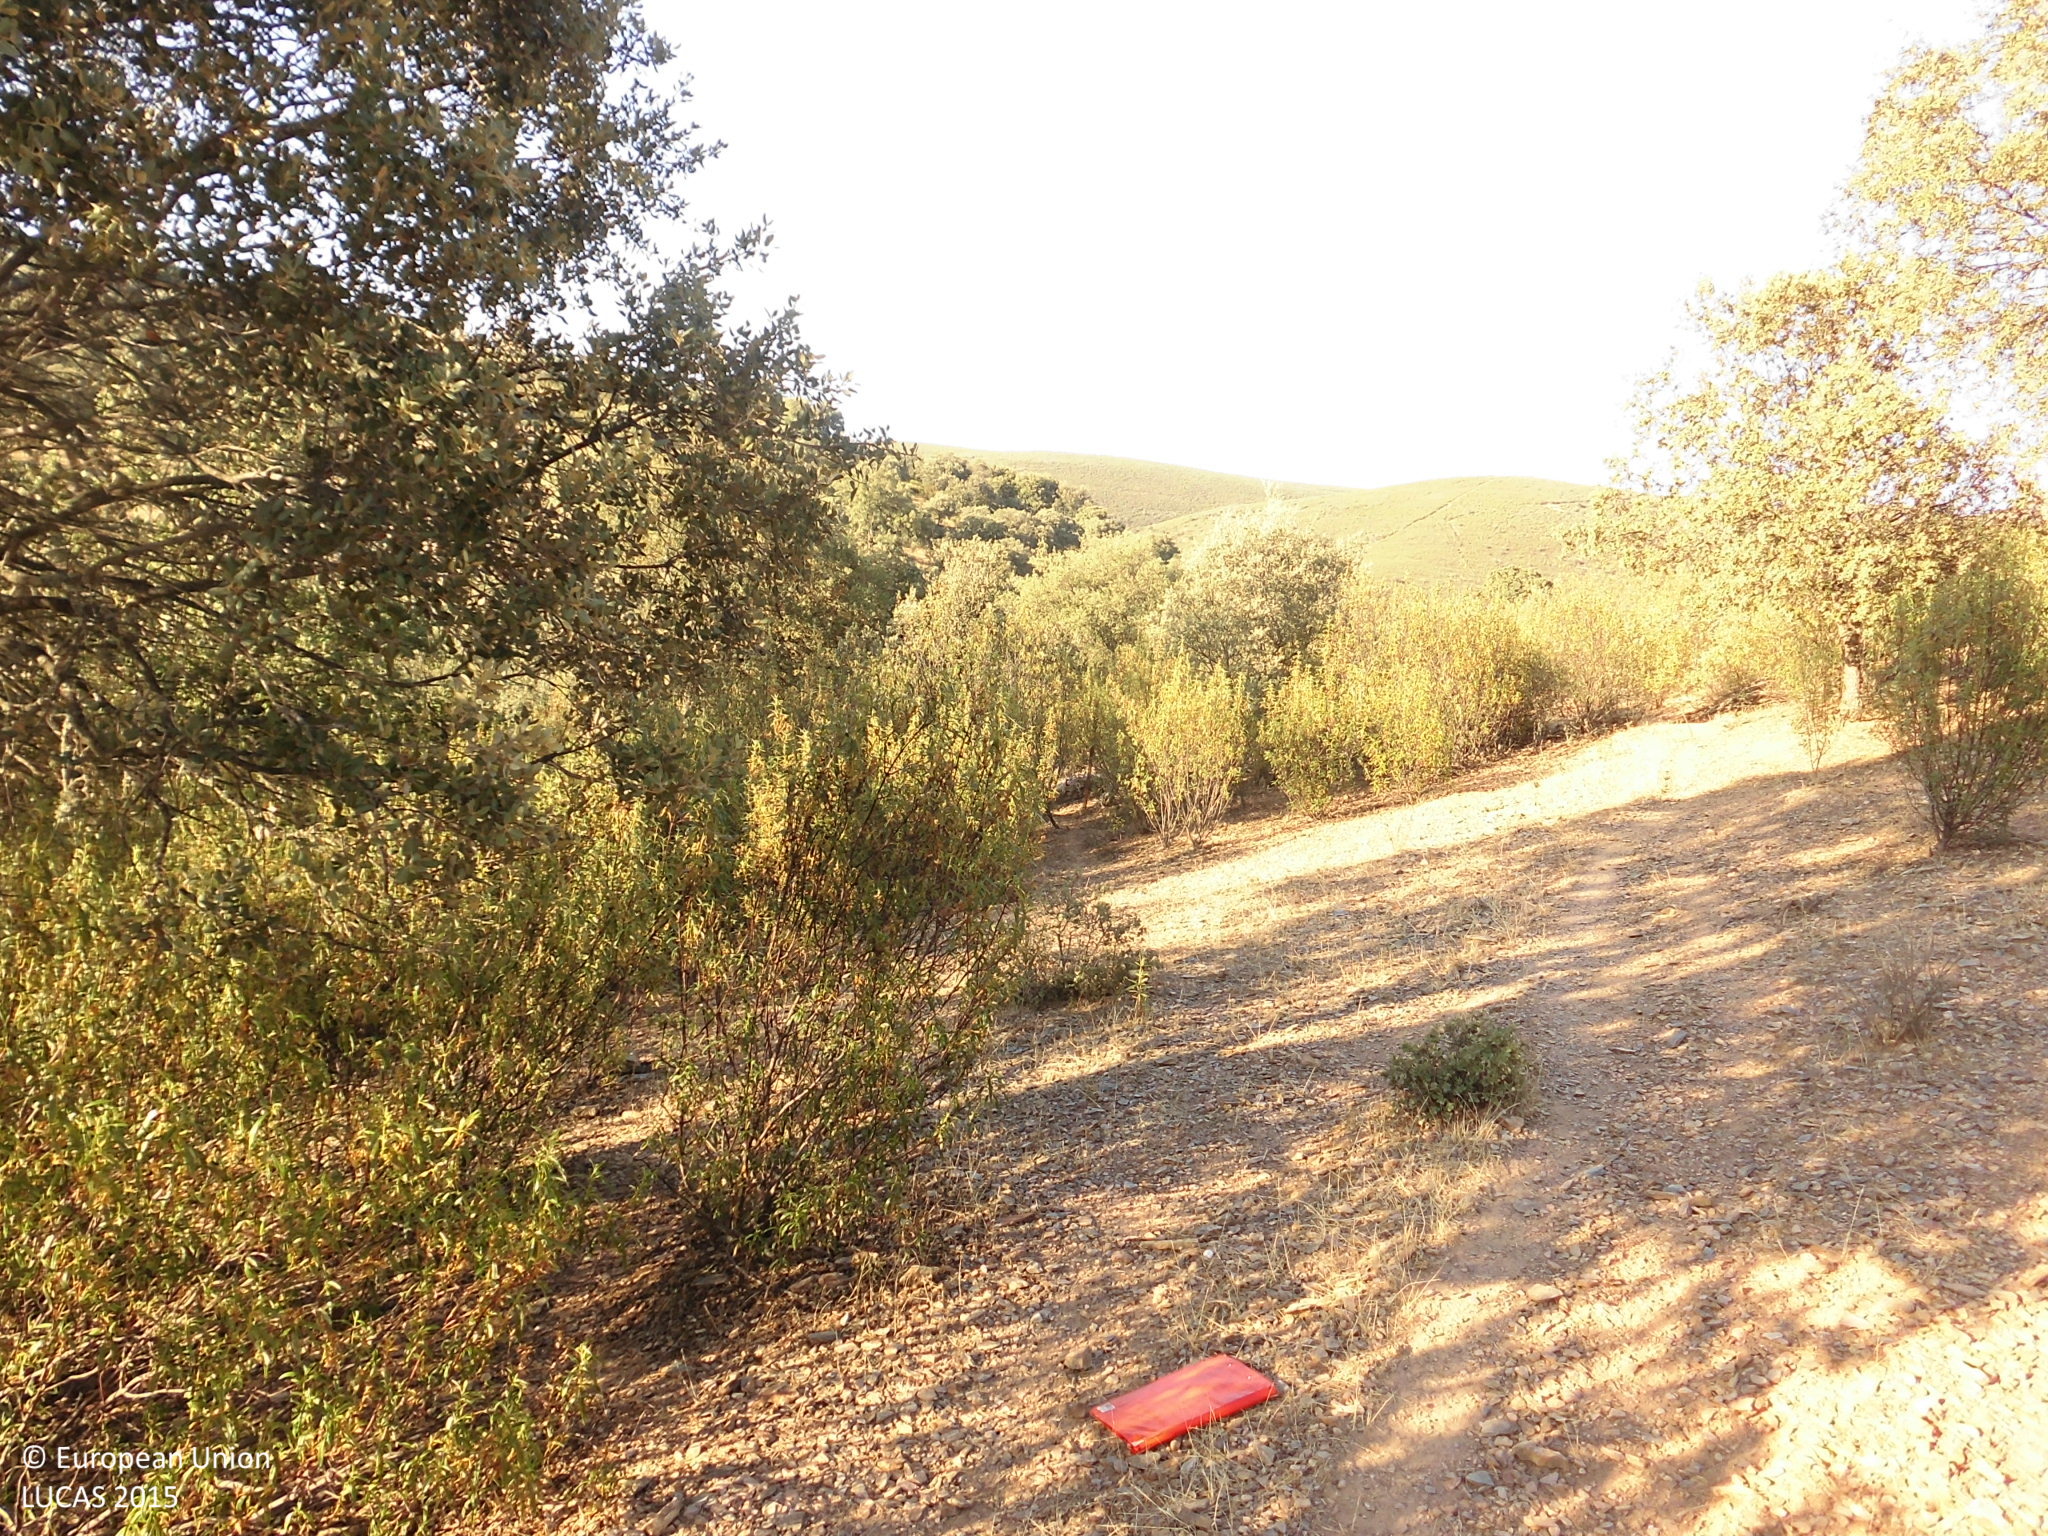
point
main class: Woodland
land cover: Broadleaved woodland
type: broadleaved evergreen forest
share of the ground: 25 - 50 %
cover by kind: broadleaved forest trees 35 %, shrubs 30 %, consolidated bare surface 25 %, herbaceous plants 10 %
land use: Semi-natural and natural areas not in use
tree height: > 5 m
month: July
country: ES
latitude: 39.6417
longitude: -5.5650
